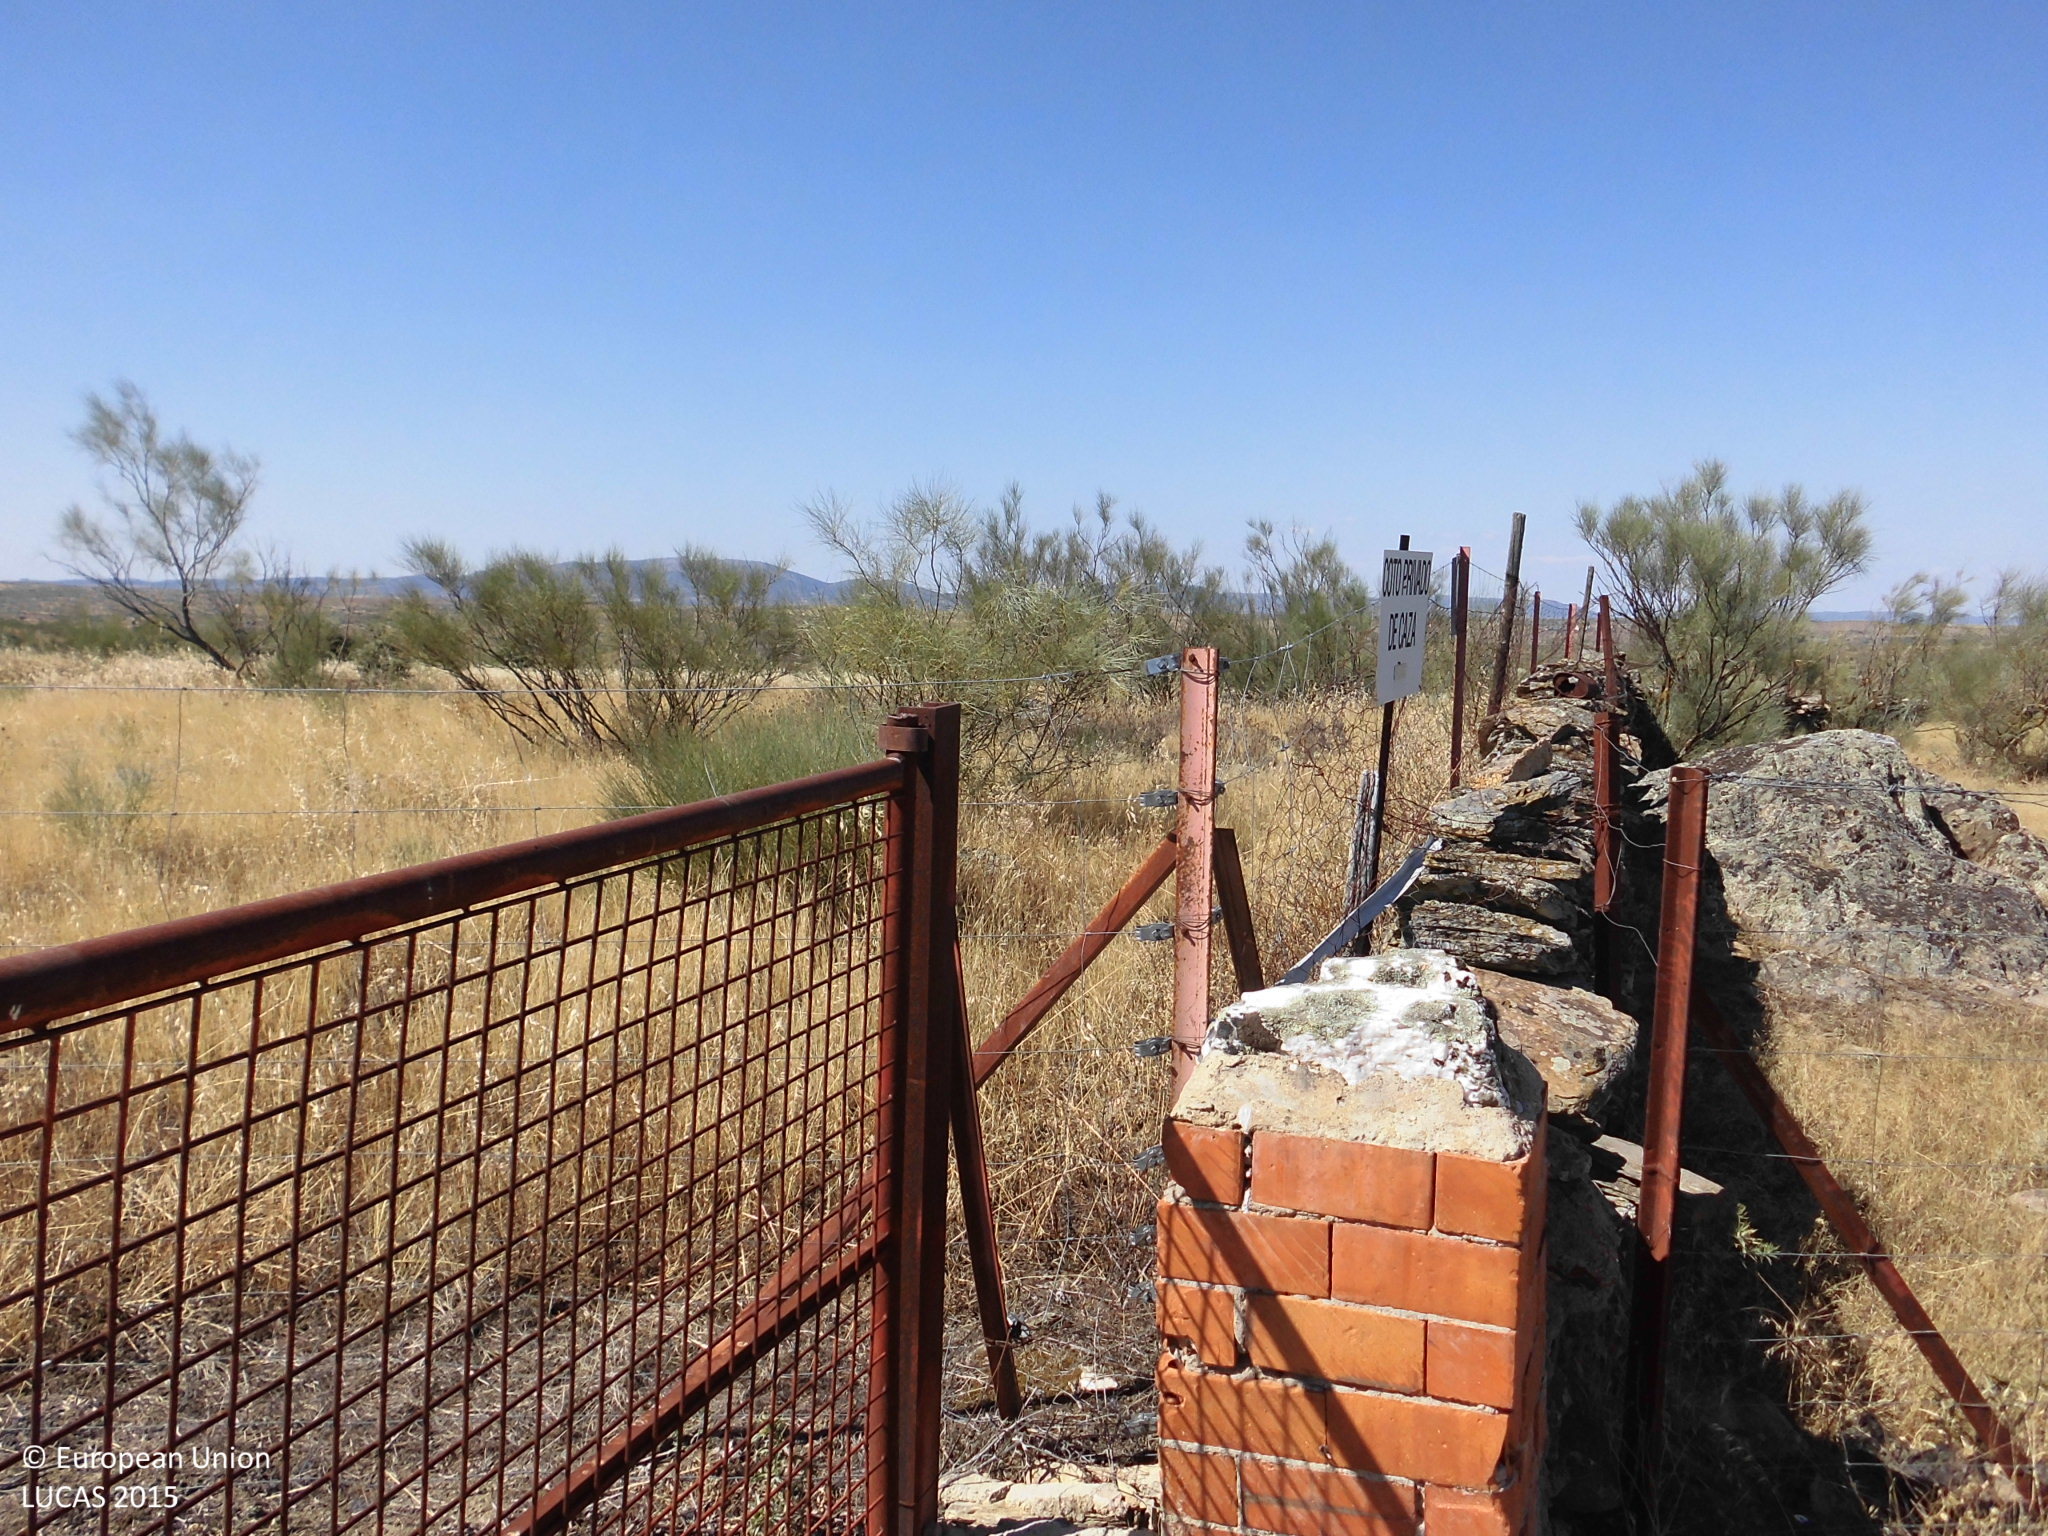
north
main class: Shrubland
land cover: Shrubland without tree cover
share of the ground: 10 - 25 %
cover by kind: herbaceous plants 80 %, shrubs 20 %
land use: Agriculture (excluding fallow land and kitchen gardens)
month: June
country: ES
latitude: 39.6642
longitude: -6.4262
